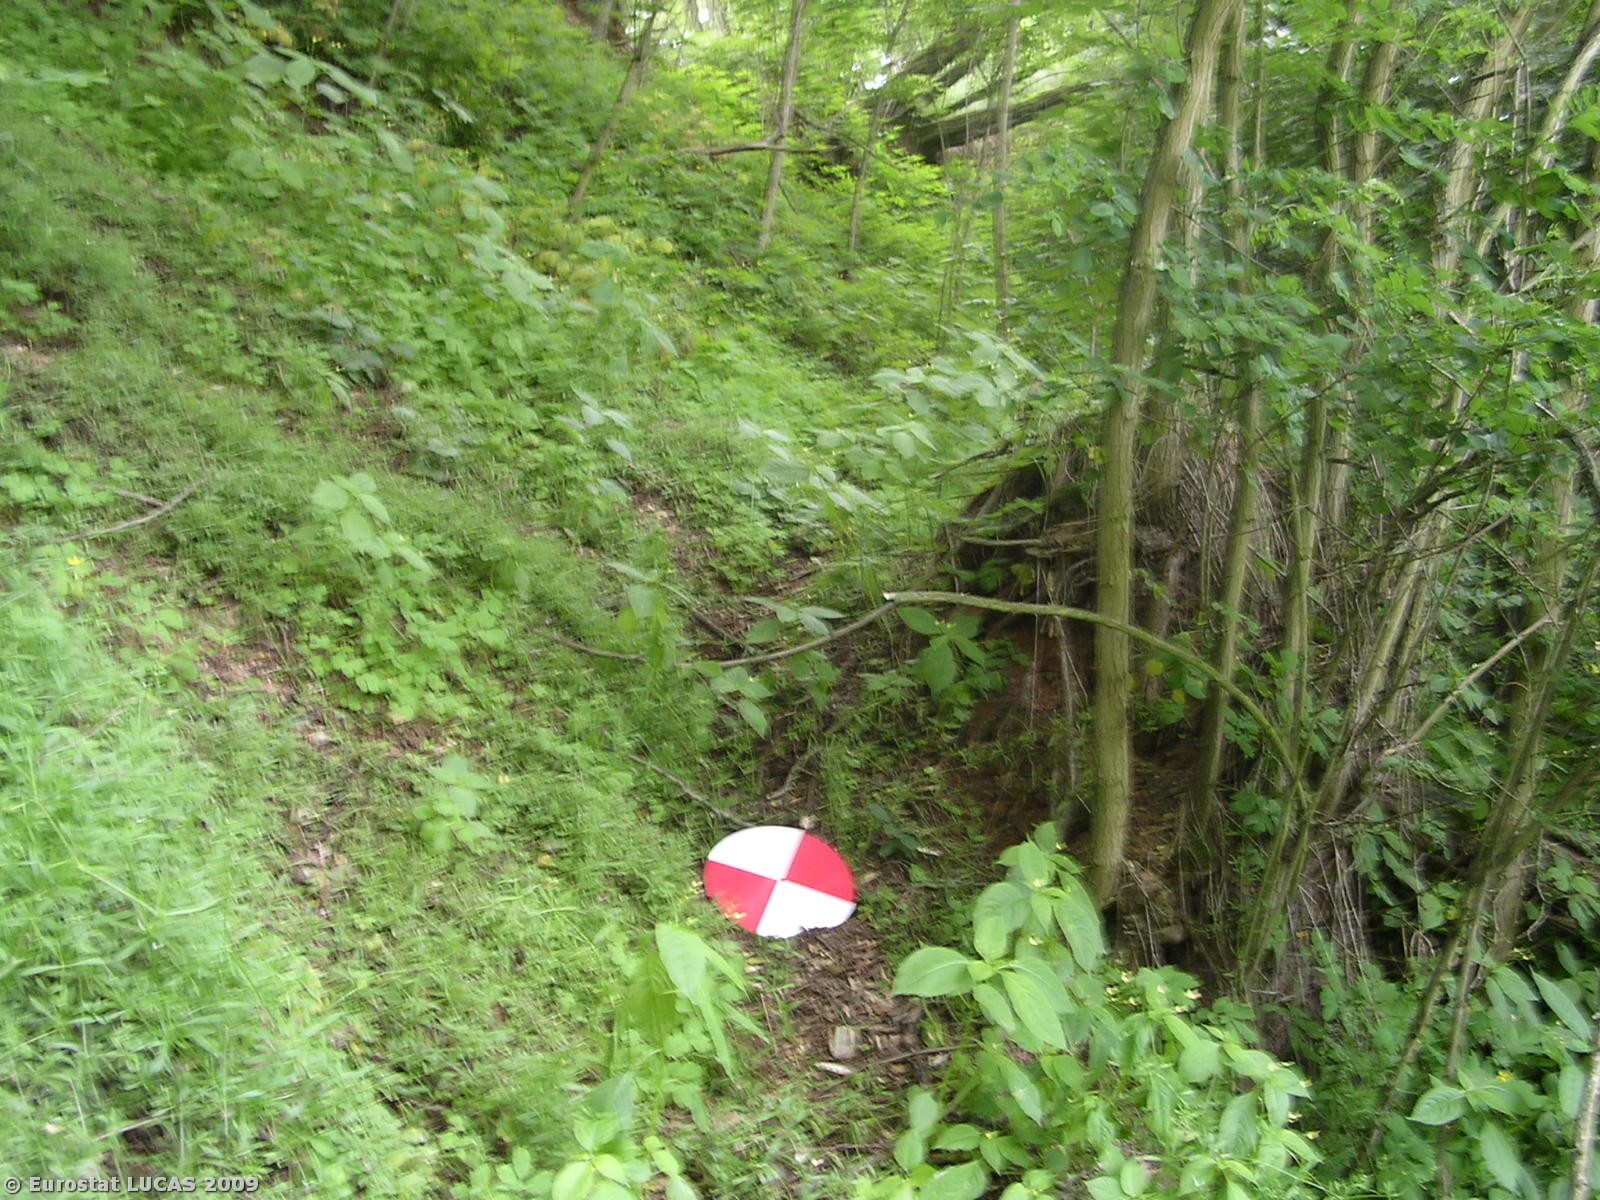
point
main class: Woodland
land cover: Broadleaved woodland
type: plantations and self-sown exotic forest
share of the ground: > 75 %
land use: Unused
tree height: > 5 m
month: June
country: CZ
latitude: 50.5091
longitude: 14.9522
